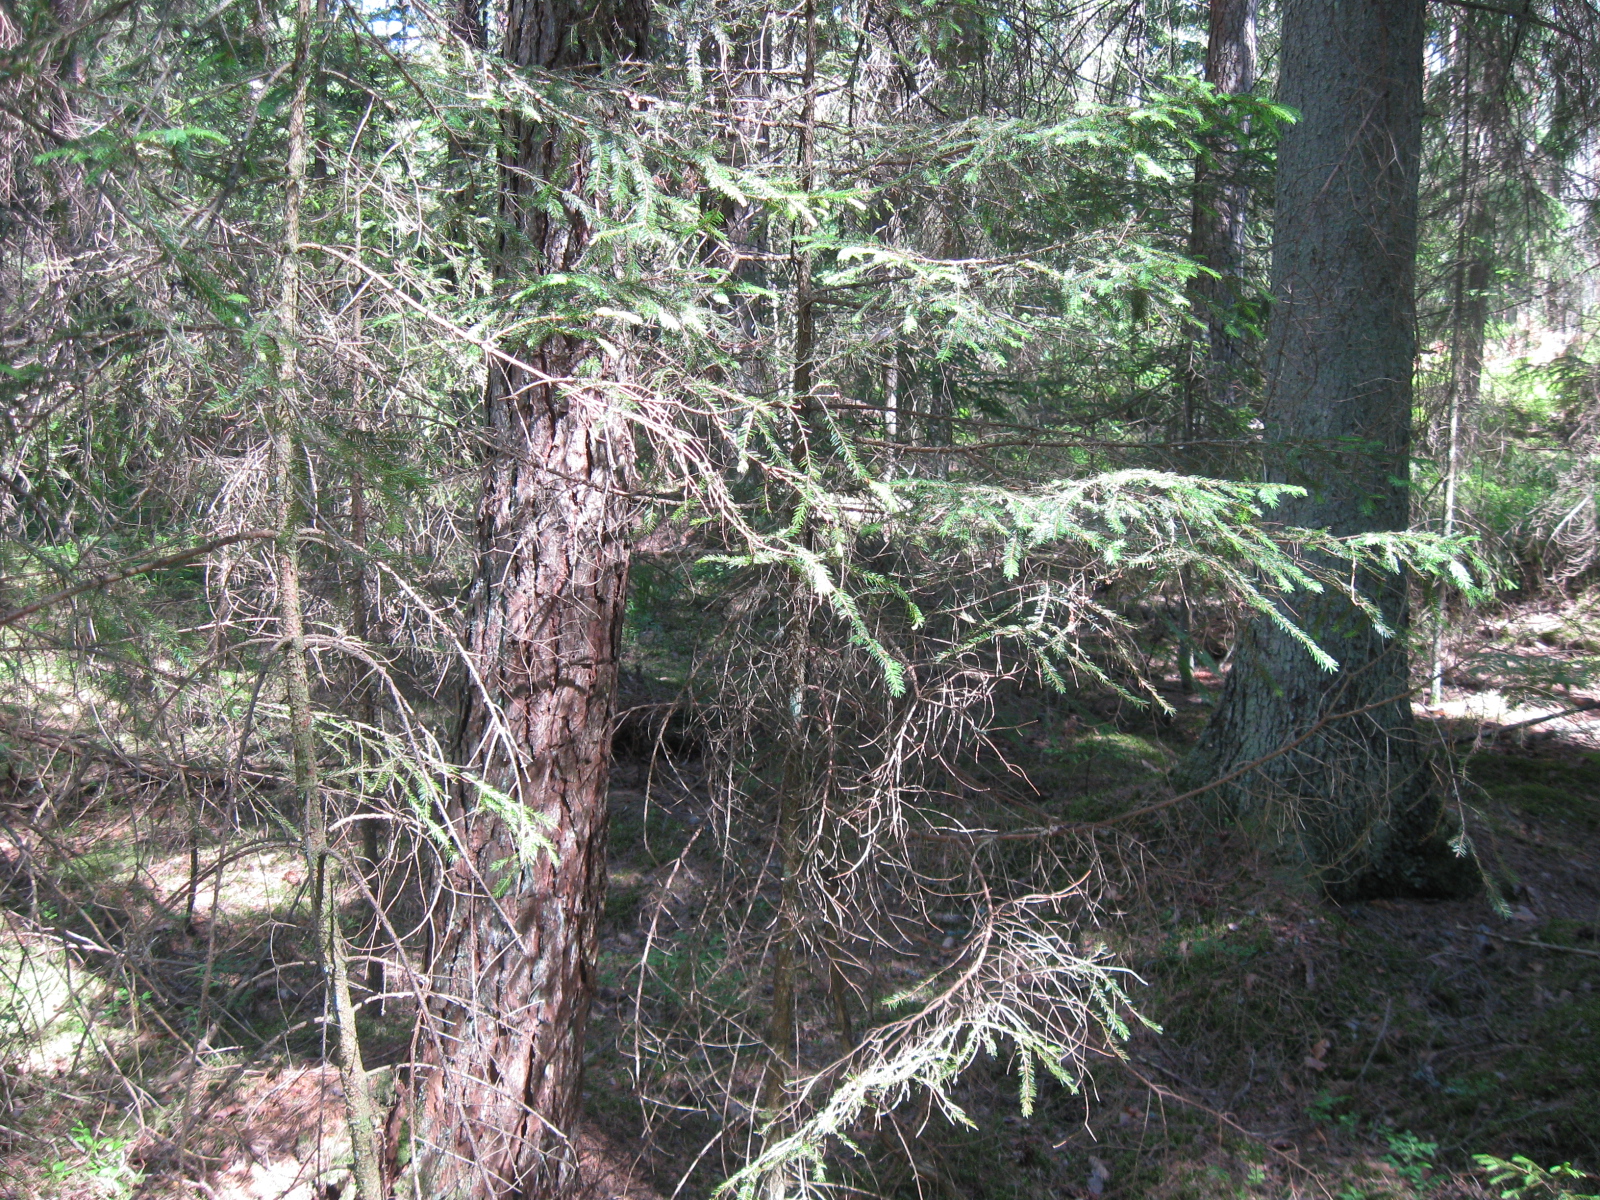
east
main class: Woodland
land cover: Other coniferous woodland
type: hemiboreal forest and nemoral coniferous forest and mixed broadleaved-coniferous forest
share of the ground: > 75 %
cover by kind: coniferous forest trees 95 %, lichens and mosses 5 %
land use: Forestry
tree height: > 5 m
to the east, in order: Other coniferous woodland; Pine dominated coniferous woodland; Tracks; Pine dominated coniferous woodland
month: June
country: LT
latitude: 53.9912
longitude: 24.1436
